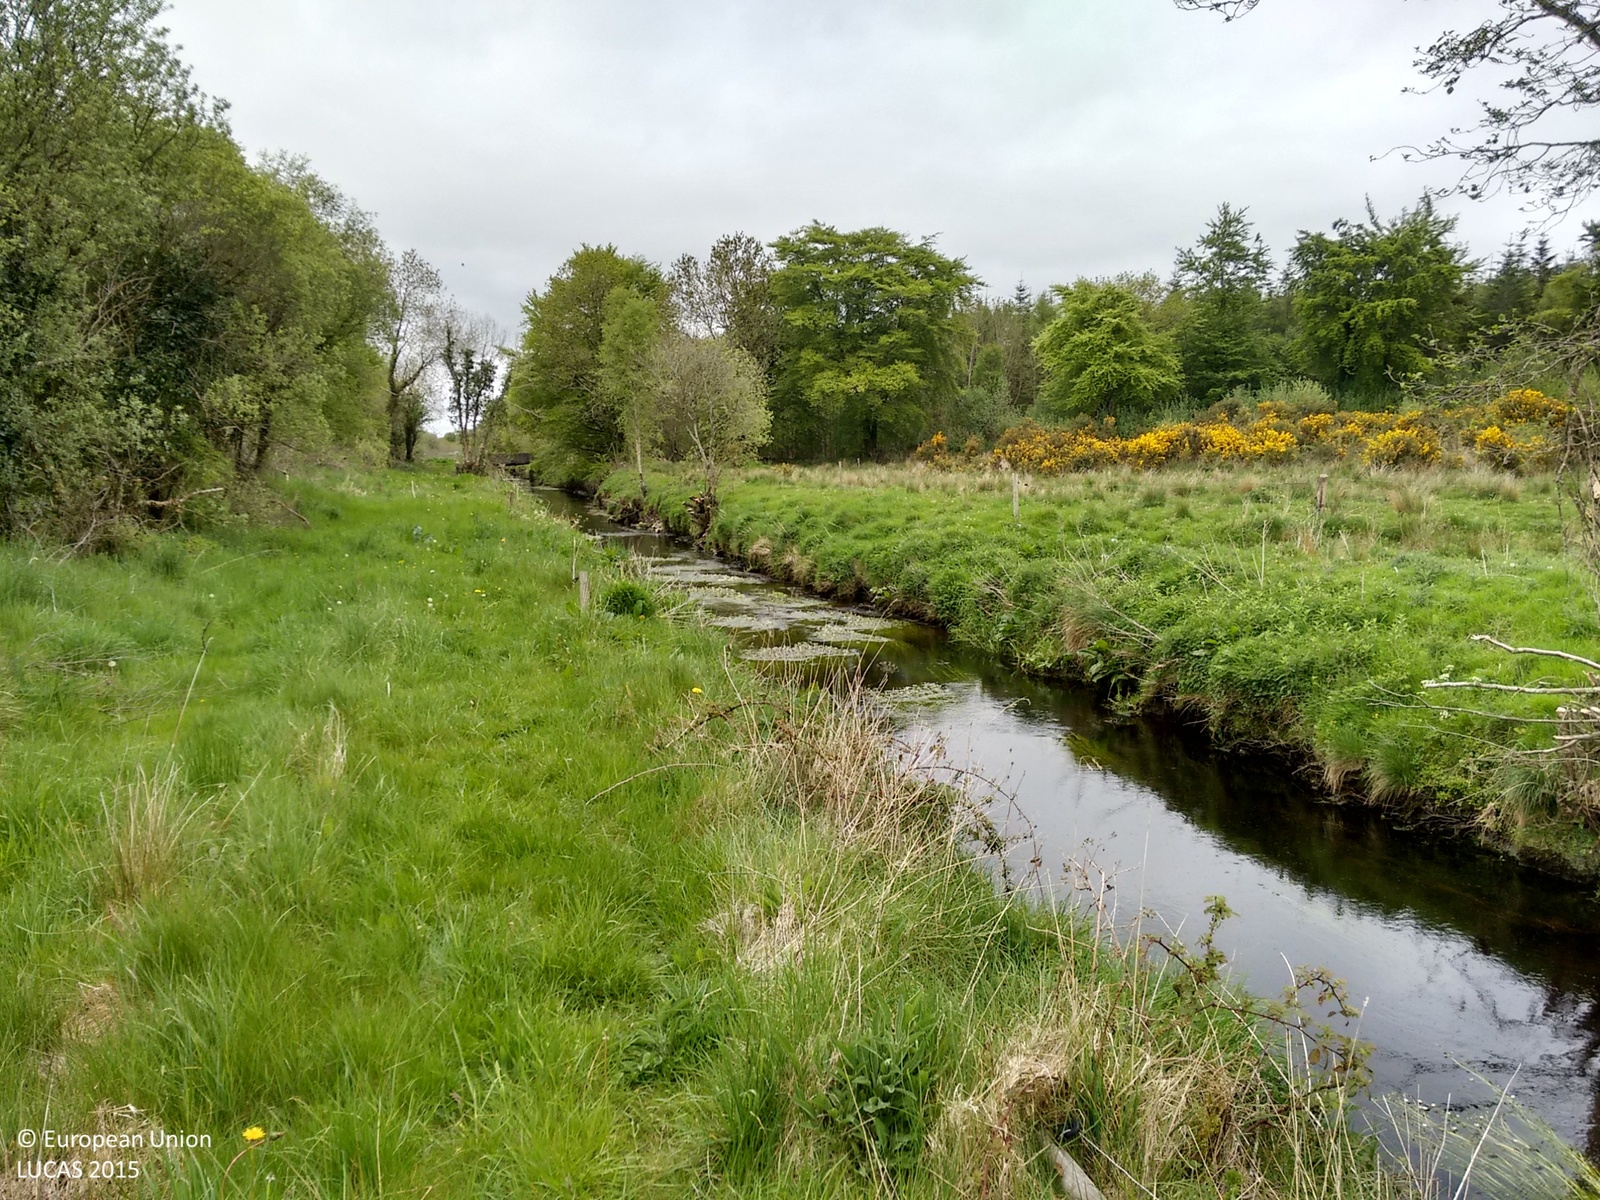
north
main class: Grassland
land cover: Grassland with sparse tree/shrub cover
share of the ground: > 75 %
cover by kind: herbaceous plants 85 %, shrubs 10 %, broadleaved forest trees 5 %
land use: Agriculture (excluding fallow land and kitchen gardens)
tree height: < 5 m
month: May
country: IE
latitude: 53.3723
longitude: -8.6721
